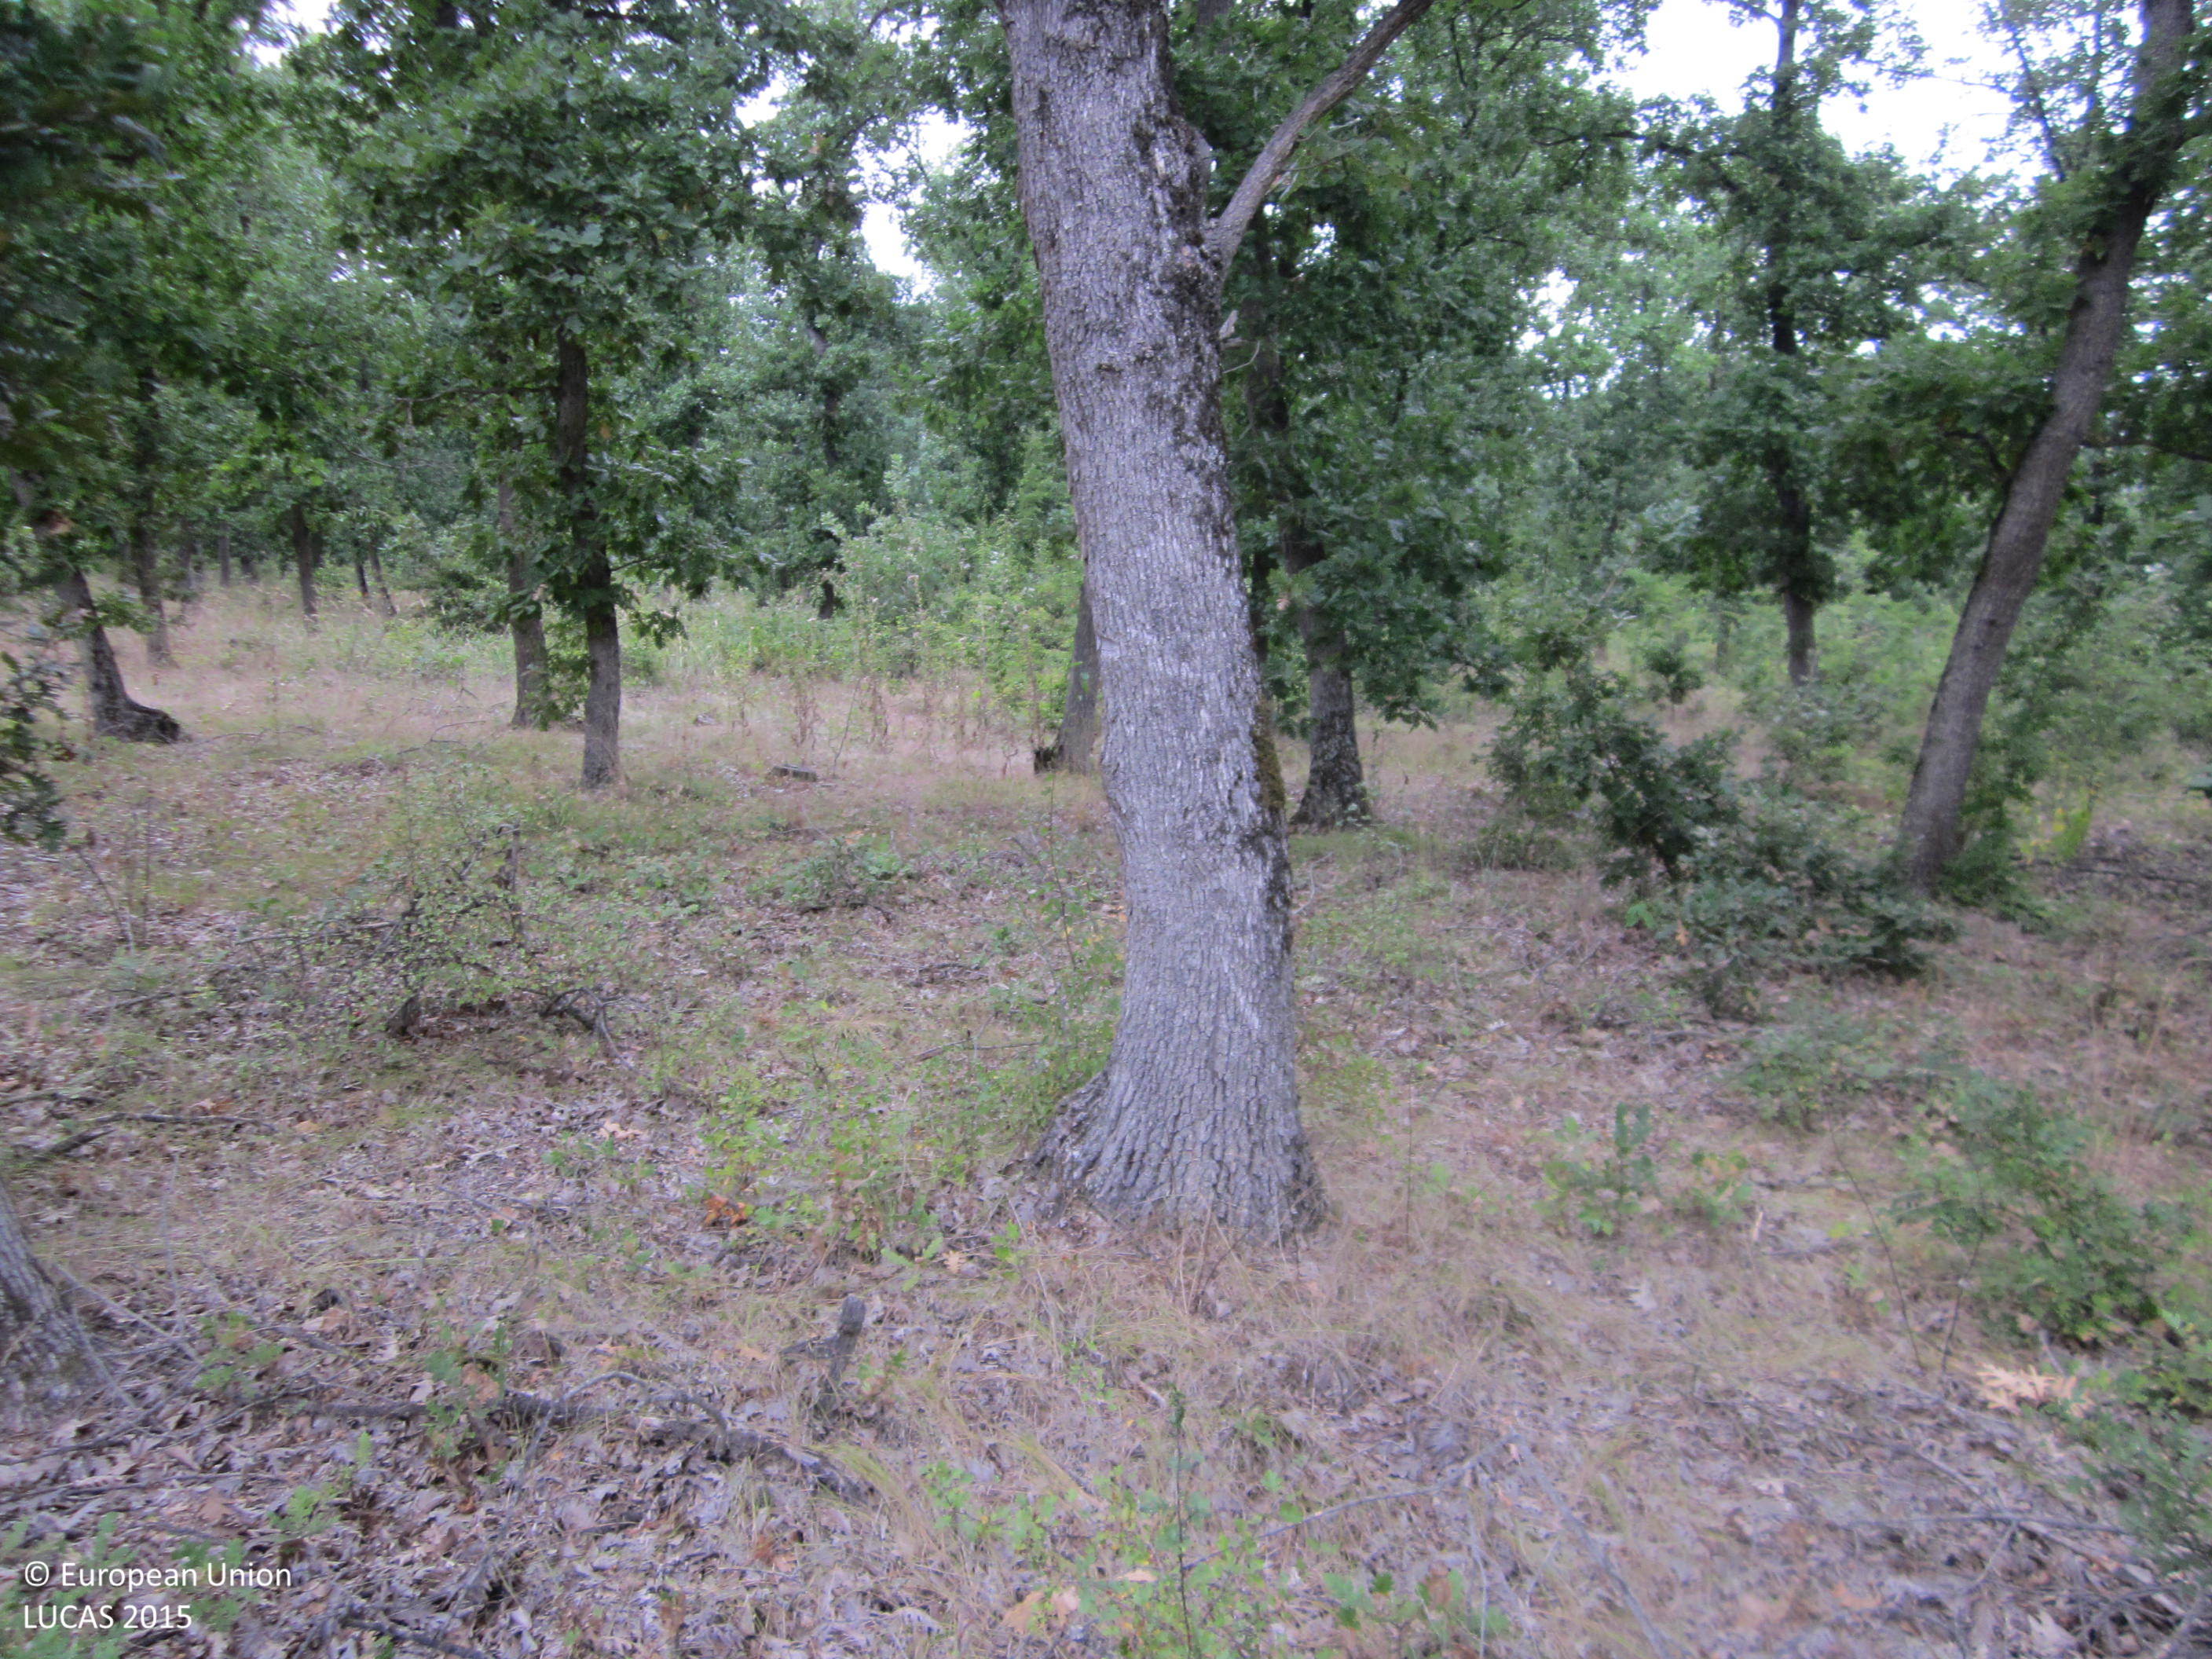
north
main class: Woodland
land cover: Broadleaved woodland
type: acidophilous oak and oak-birch forest
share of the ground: 50 - 75 %
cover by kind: broadleaved forest trees 60 %, herbaceous plants 30 %, shrubs 5 %, unconsolidated bare surface 5 %
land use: Forestry
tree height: > 5 m
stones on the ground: < 10 %
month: September
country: BG
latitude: 42.7597
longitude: 27.4845
